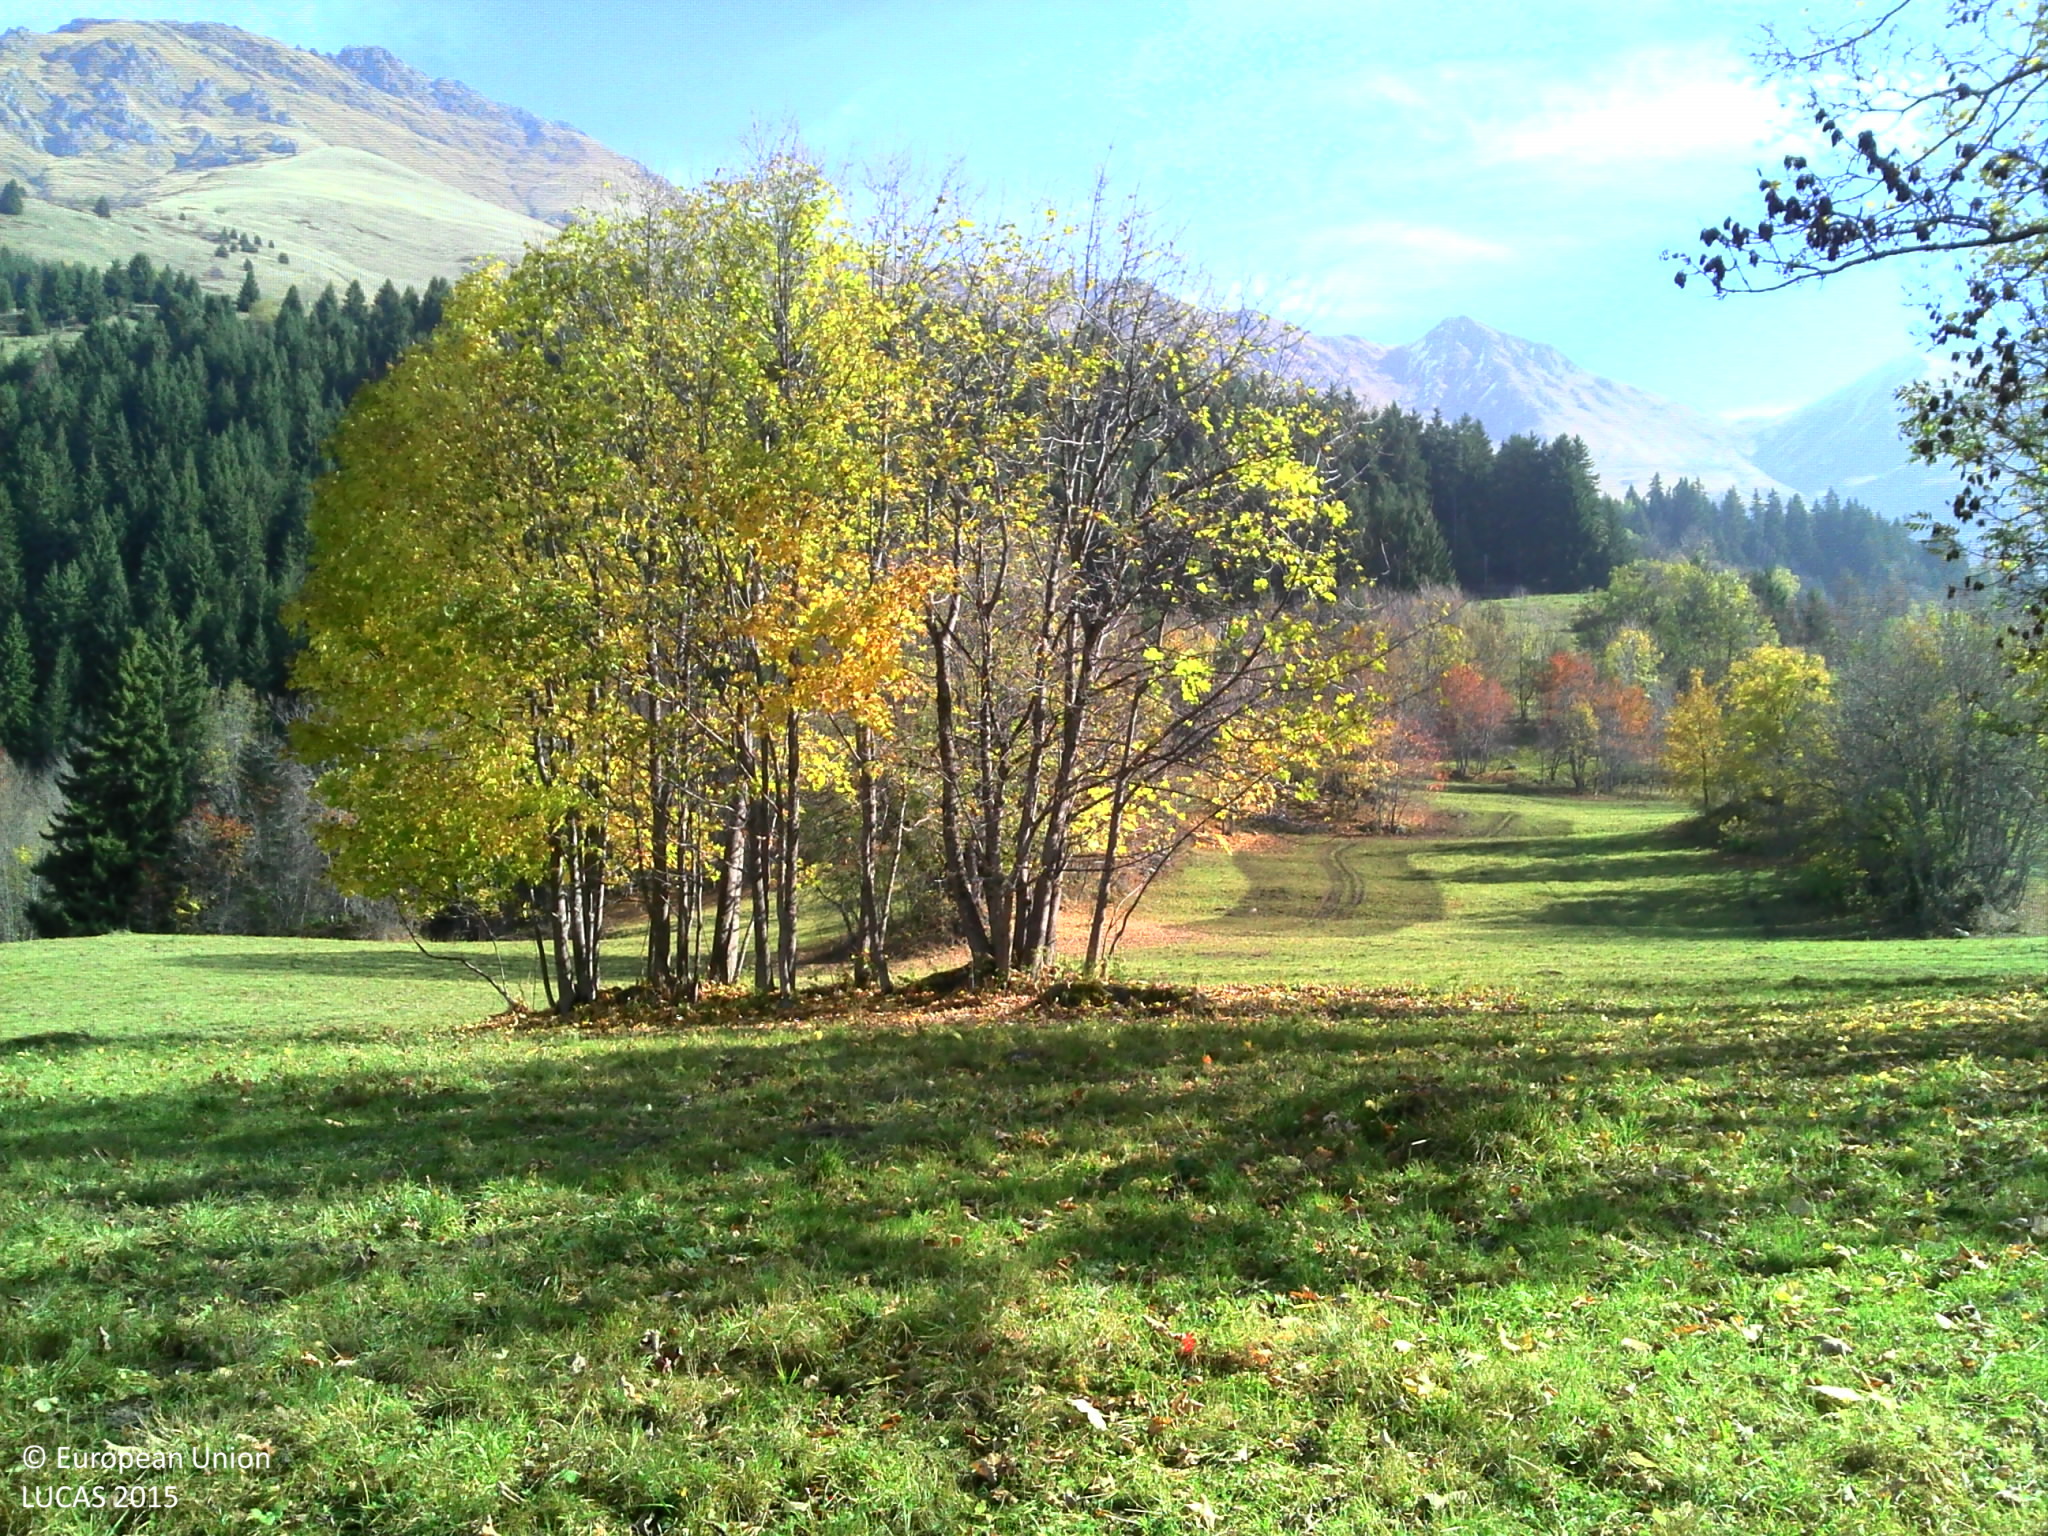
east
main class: Woodland
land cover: Broadleaved woodland
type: mesophytic deciduous forest
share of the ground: 25 - 50 %
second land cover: Grassland without tree/shrub cover
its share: > 75 %
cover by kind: herbaceous plants 70 %, broadleaved forest trees 30 %
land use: Forestry
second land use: Agriculture (excluding fallow land and kitchen gardens)
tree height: > 5 m
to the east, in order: Broadleaved woodland; Grassland without tree/shrub cover; Tracks; Grassland without tree/shrub cover; Broadleaved woodland; Grassland without tree/shrub cover; Fences; Broadleaved woodland; Fences; Spruce dominated coniferous woodland; Fences; Spruce dominated coniferous woodland
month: October
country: FR
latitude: 45.3697
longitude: 6.3659
